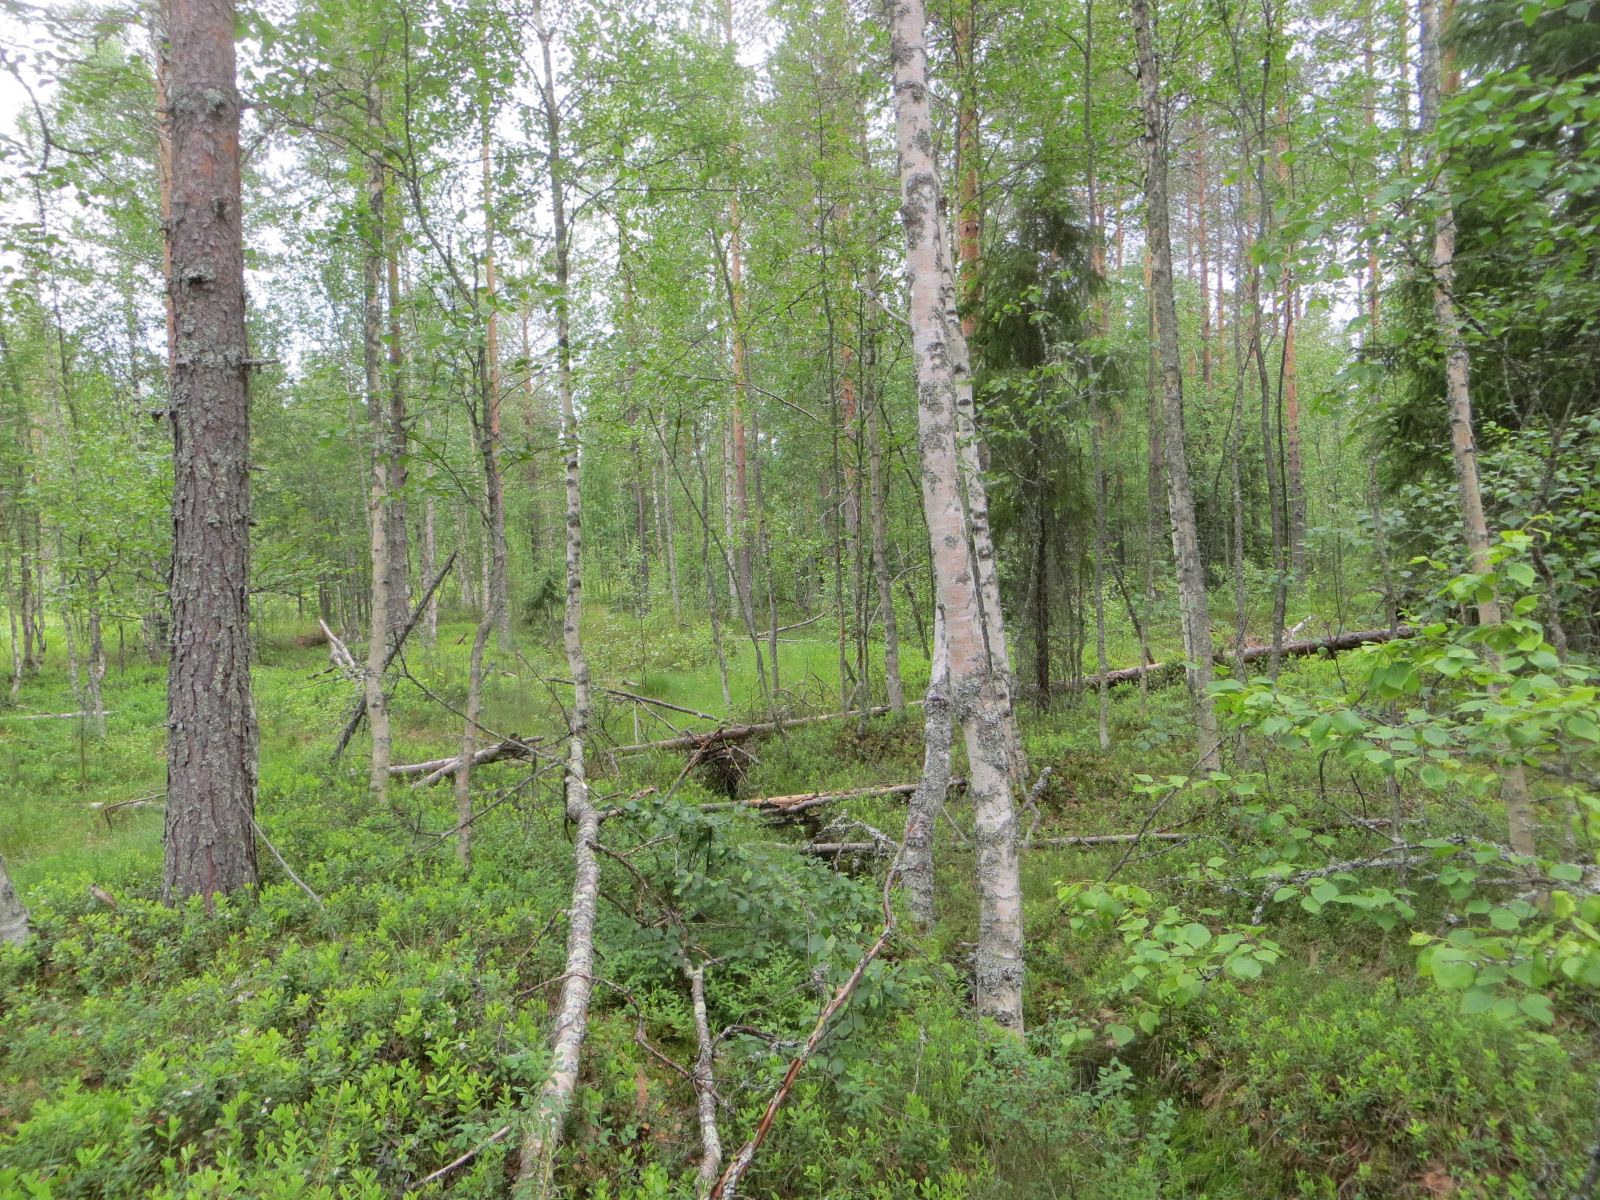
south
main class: Woodland
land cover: Pine dominated mixed woodland
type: boreal forest
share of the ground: 50 - 75 %
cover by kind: coniferous forest trees 50 %, shrubs 30 %, broadleaved forest trees 20 %
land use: Forestry
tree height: > 5 m
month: July
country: FI
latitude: 65.4726
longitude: 25.9559
